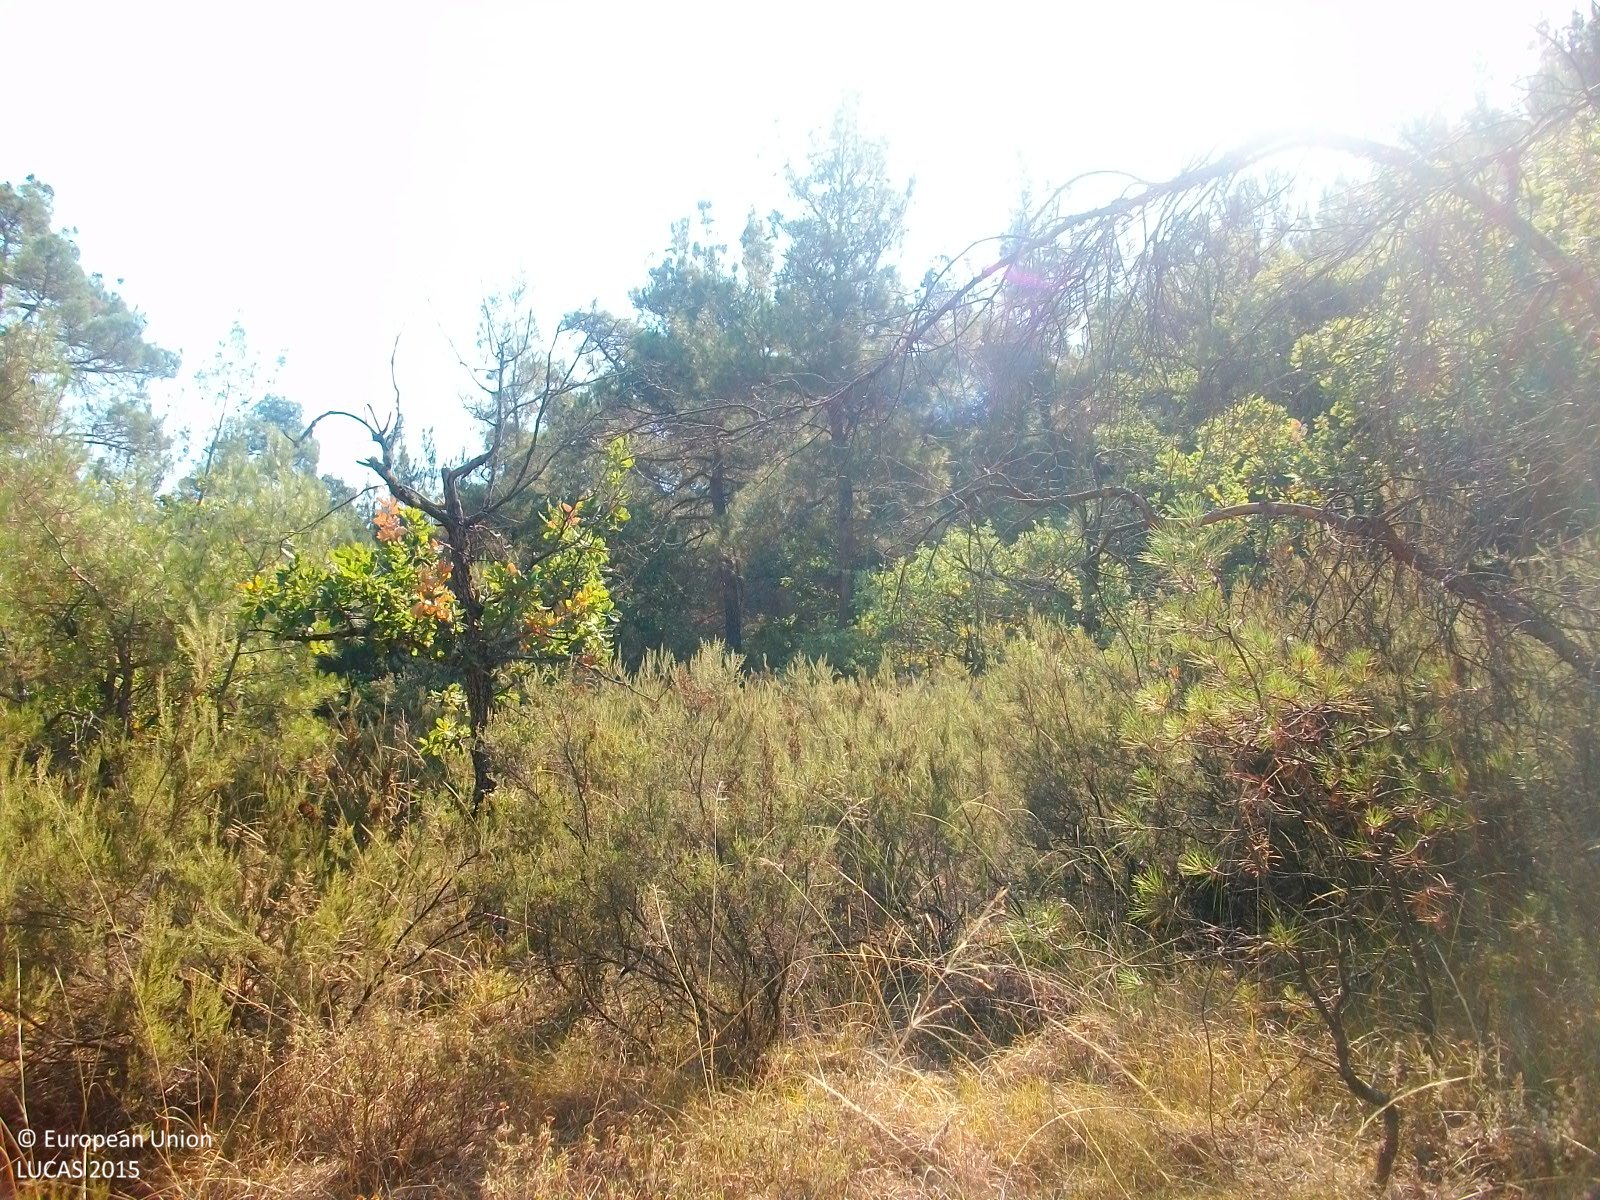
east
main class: Woodland
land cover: Pine dominated coniferous woodland
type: coniferous forest of the mediterranean region
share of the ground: > 75 %
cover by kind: coniferous forest trees 90 %, shrubs 5 %, herbaceous plants 5 %
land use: Forestry
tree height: > 5 m
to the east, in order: Pine dominated coniferous woodland; Grassland without tree/shrub cover
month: July
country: GR
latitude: 41.0969
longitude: 26.2232
